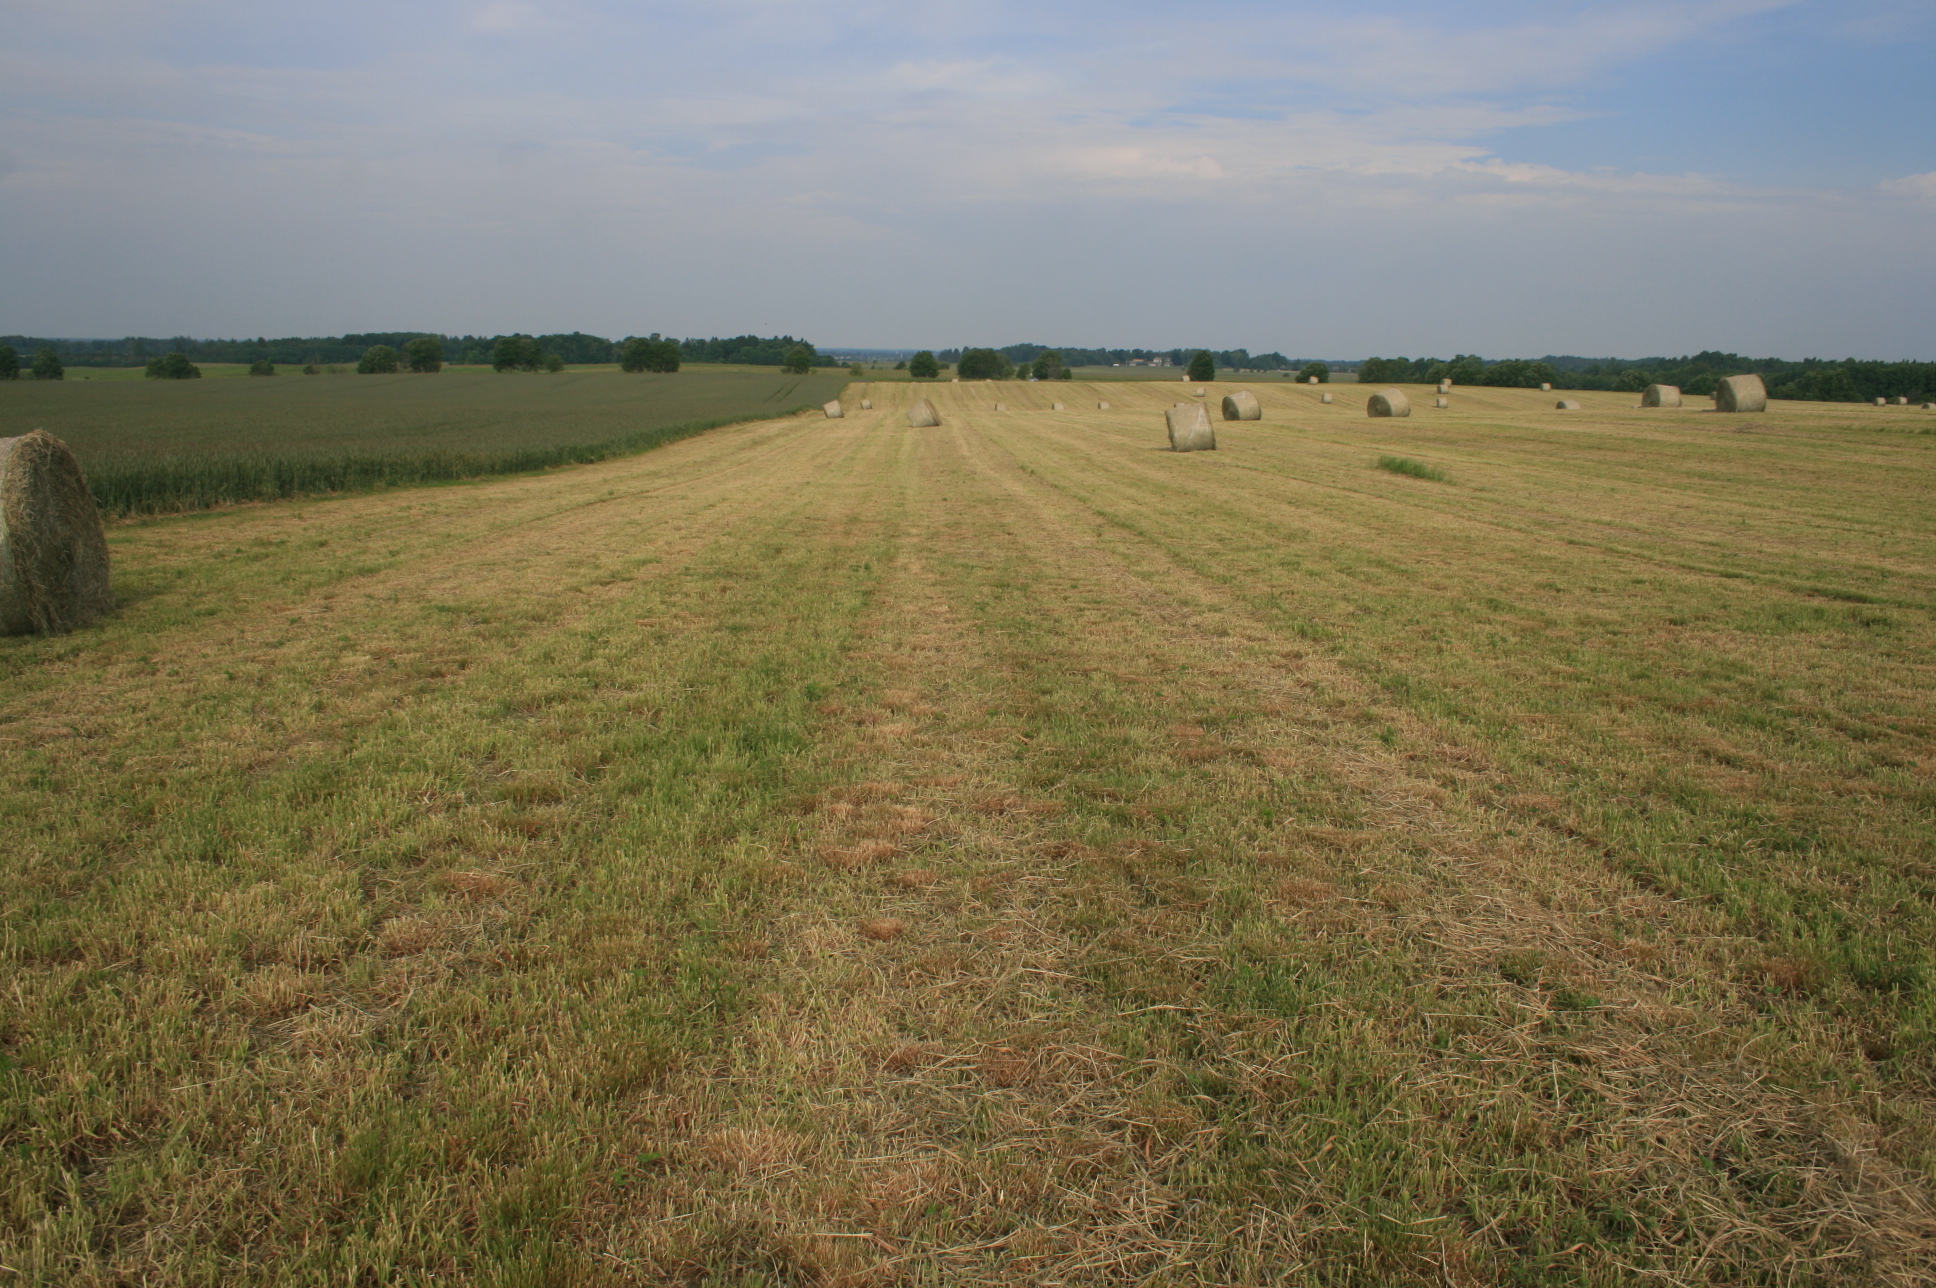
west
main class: Grassland
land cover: Grassland without tree/shrub cover
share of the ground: > 75 %
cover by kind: herbaceous plants 100 %
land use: Agriculture (excluding fallow land and kitchen gardens)
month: June
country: LT
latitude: 55.7269
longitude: 22.2367
